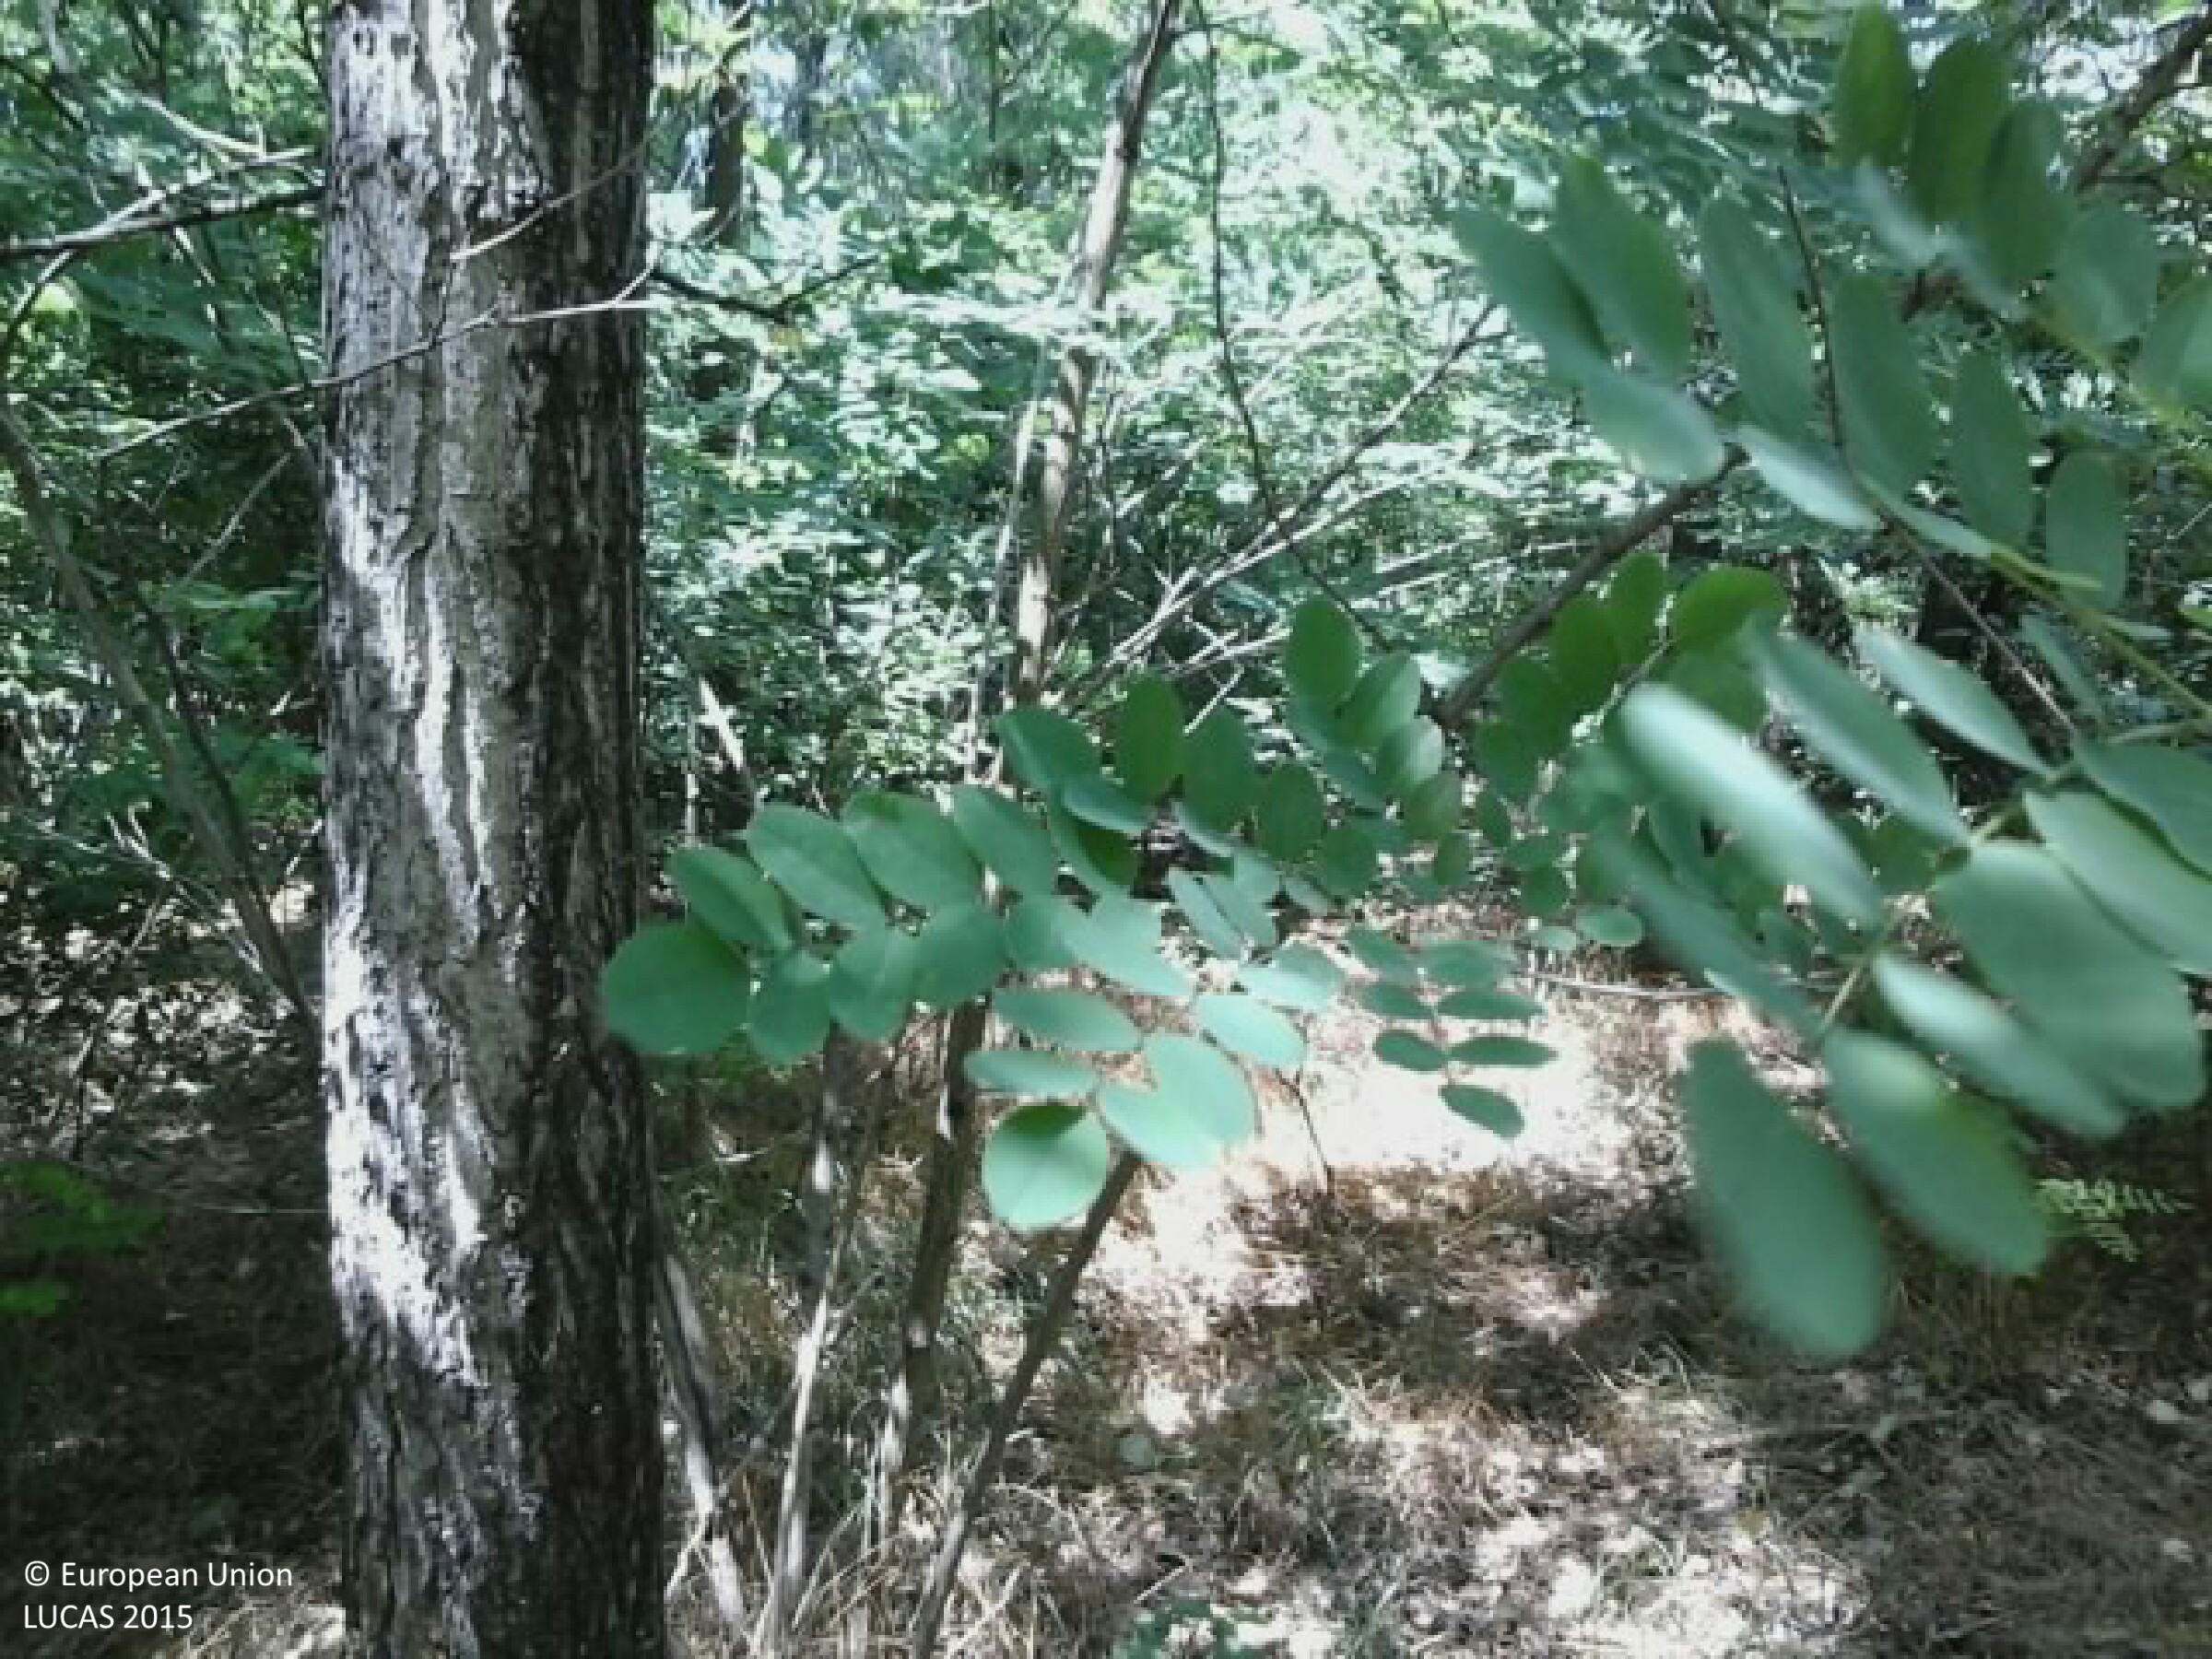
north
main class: Woodland
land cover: Broadleaved woodland
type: mesophytic deciduous forest
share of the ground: > 75 %
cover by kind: broadleaved forest trees 80 %, shrubs 20 %
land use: Forestry
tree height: < 5 m
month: June
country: HU
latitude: 46.1179
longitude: 18.9793
